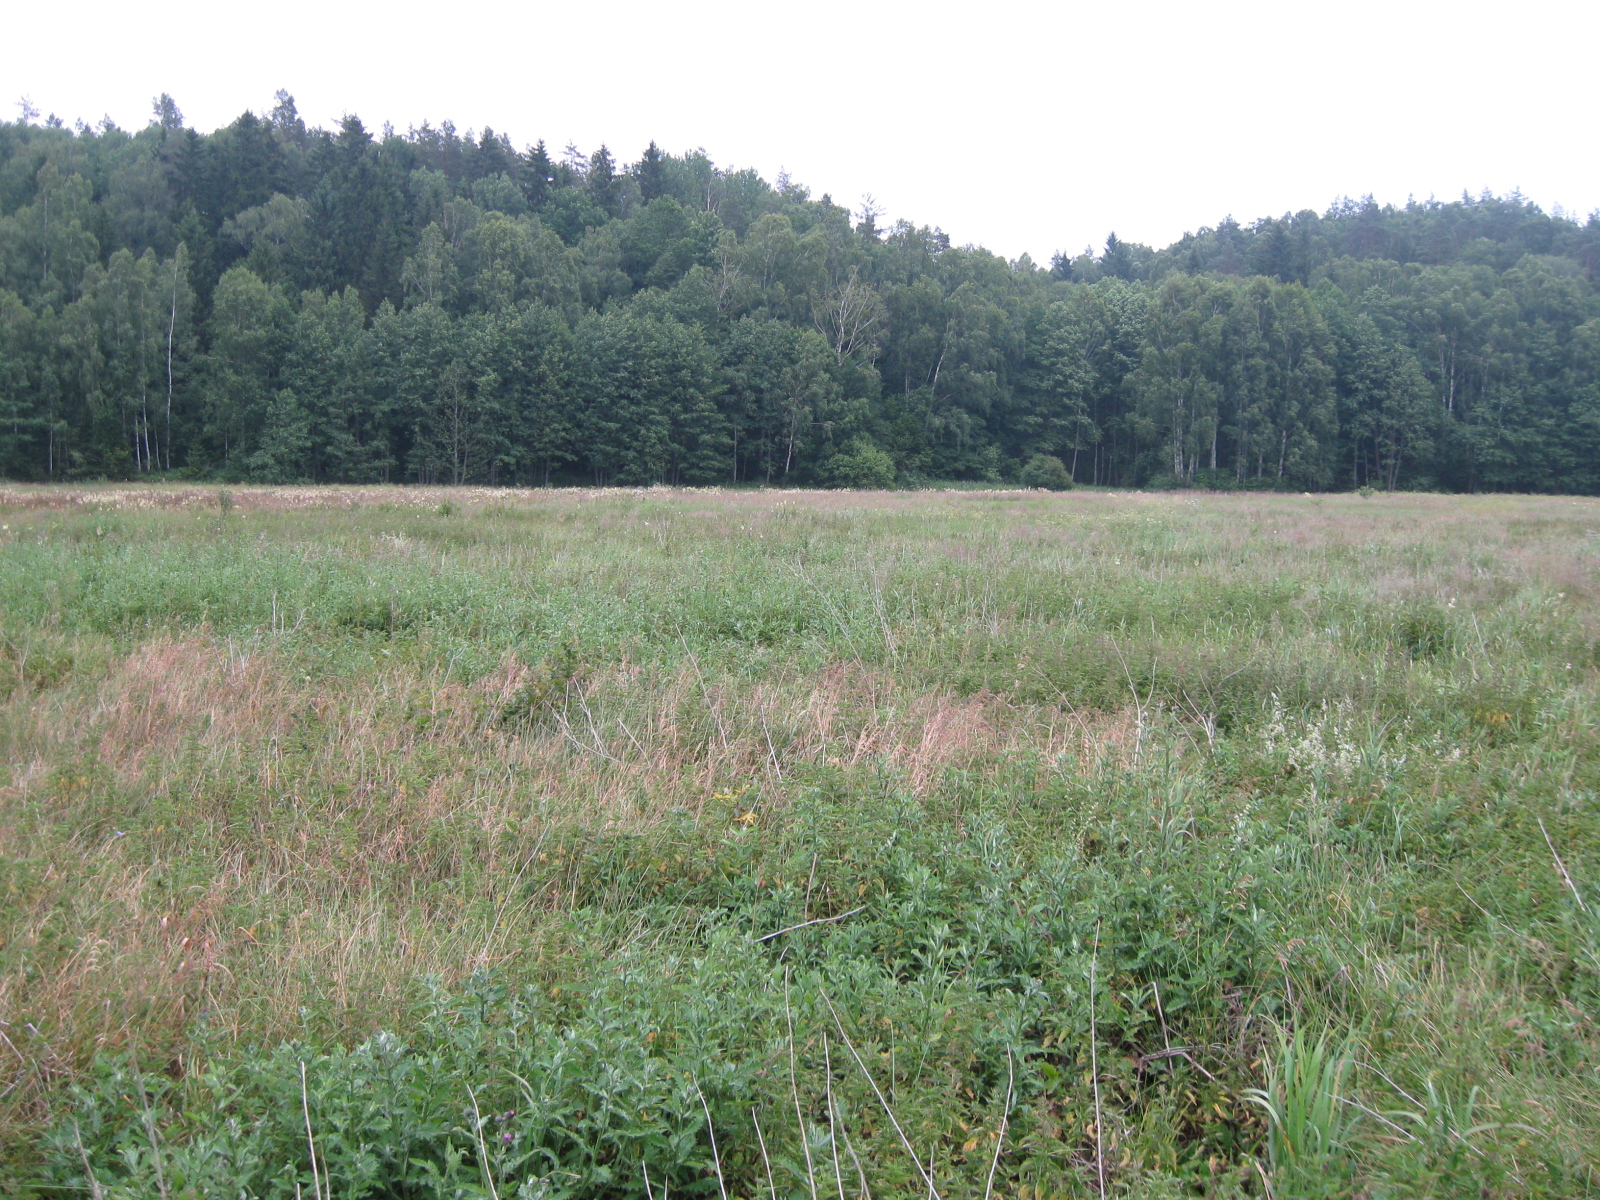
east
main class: Grassland
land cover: Spontaneously vegetated surfaces
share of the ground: > 75 %
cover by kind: herbaceous plants 100 %
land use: Abandoned areas
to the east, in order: Spontaneously vegetated surfaces; Rivers and streams; Other mixed woodland; Pine dominated mixed woodland
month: July
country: LT
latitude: 54.0791
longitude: 24.1738
